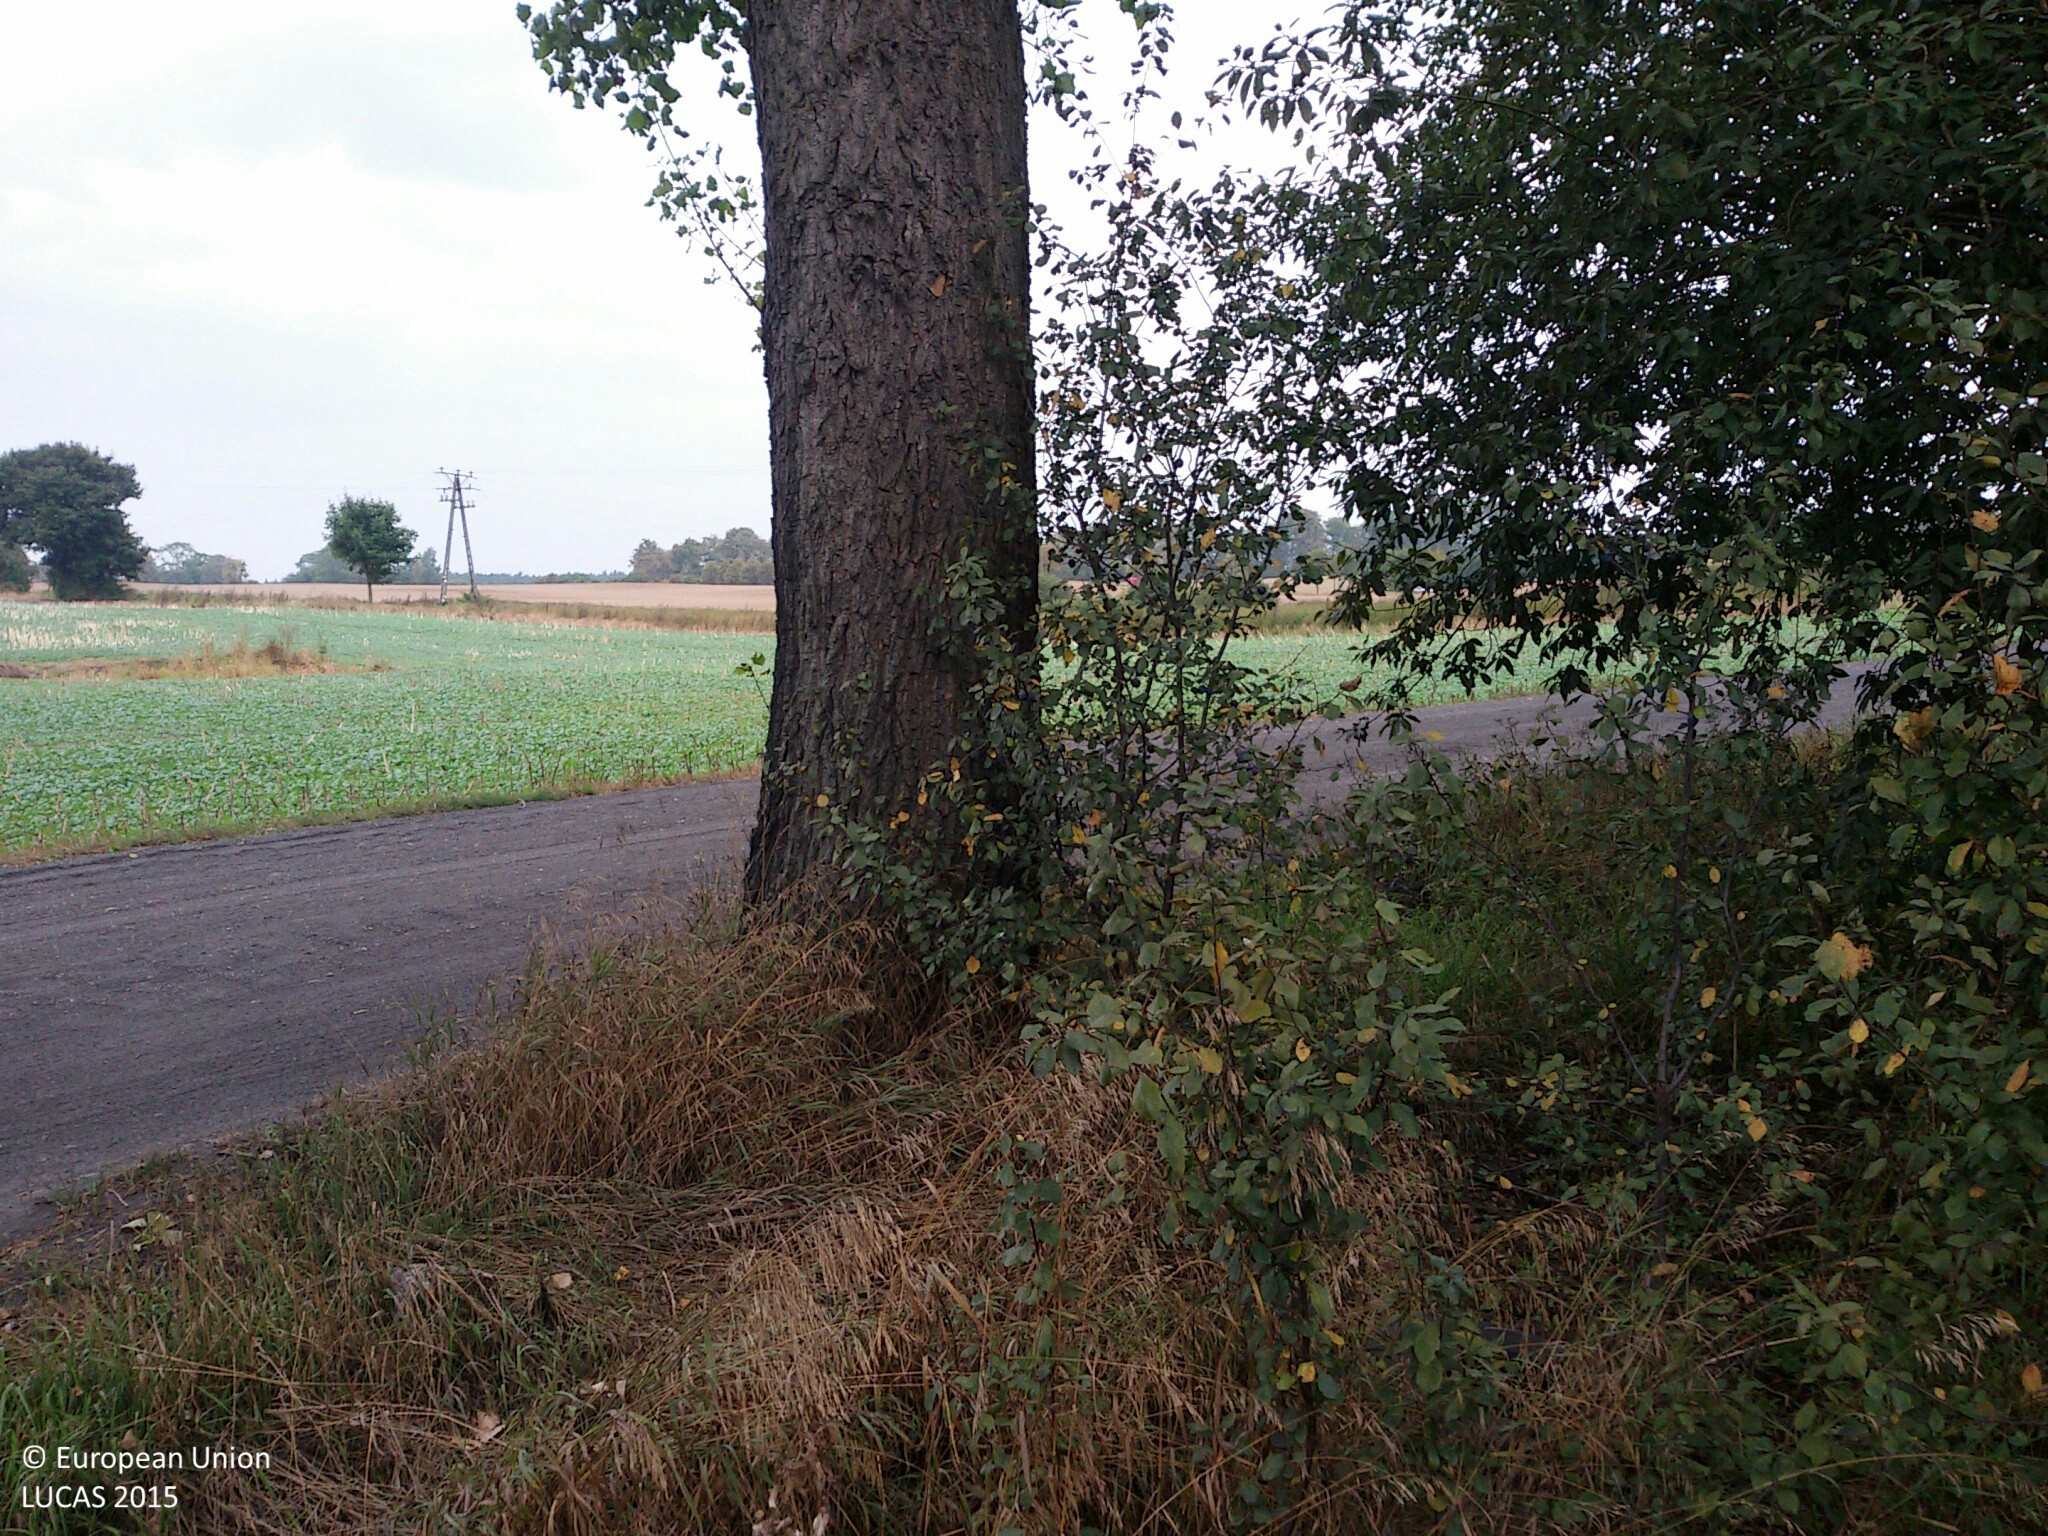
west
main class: Grassland
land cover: Grassland with sparse tree/shrub cover
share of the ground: > 75 %
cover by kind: herbaceous plants 85 %, shrubs 10 %, broadleaved forest trees 5 %
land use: Abandoned areas
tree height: > 5 m
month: September
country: PL
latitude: 53.7311
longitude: 20.2047
